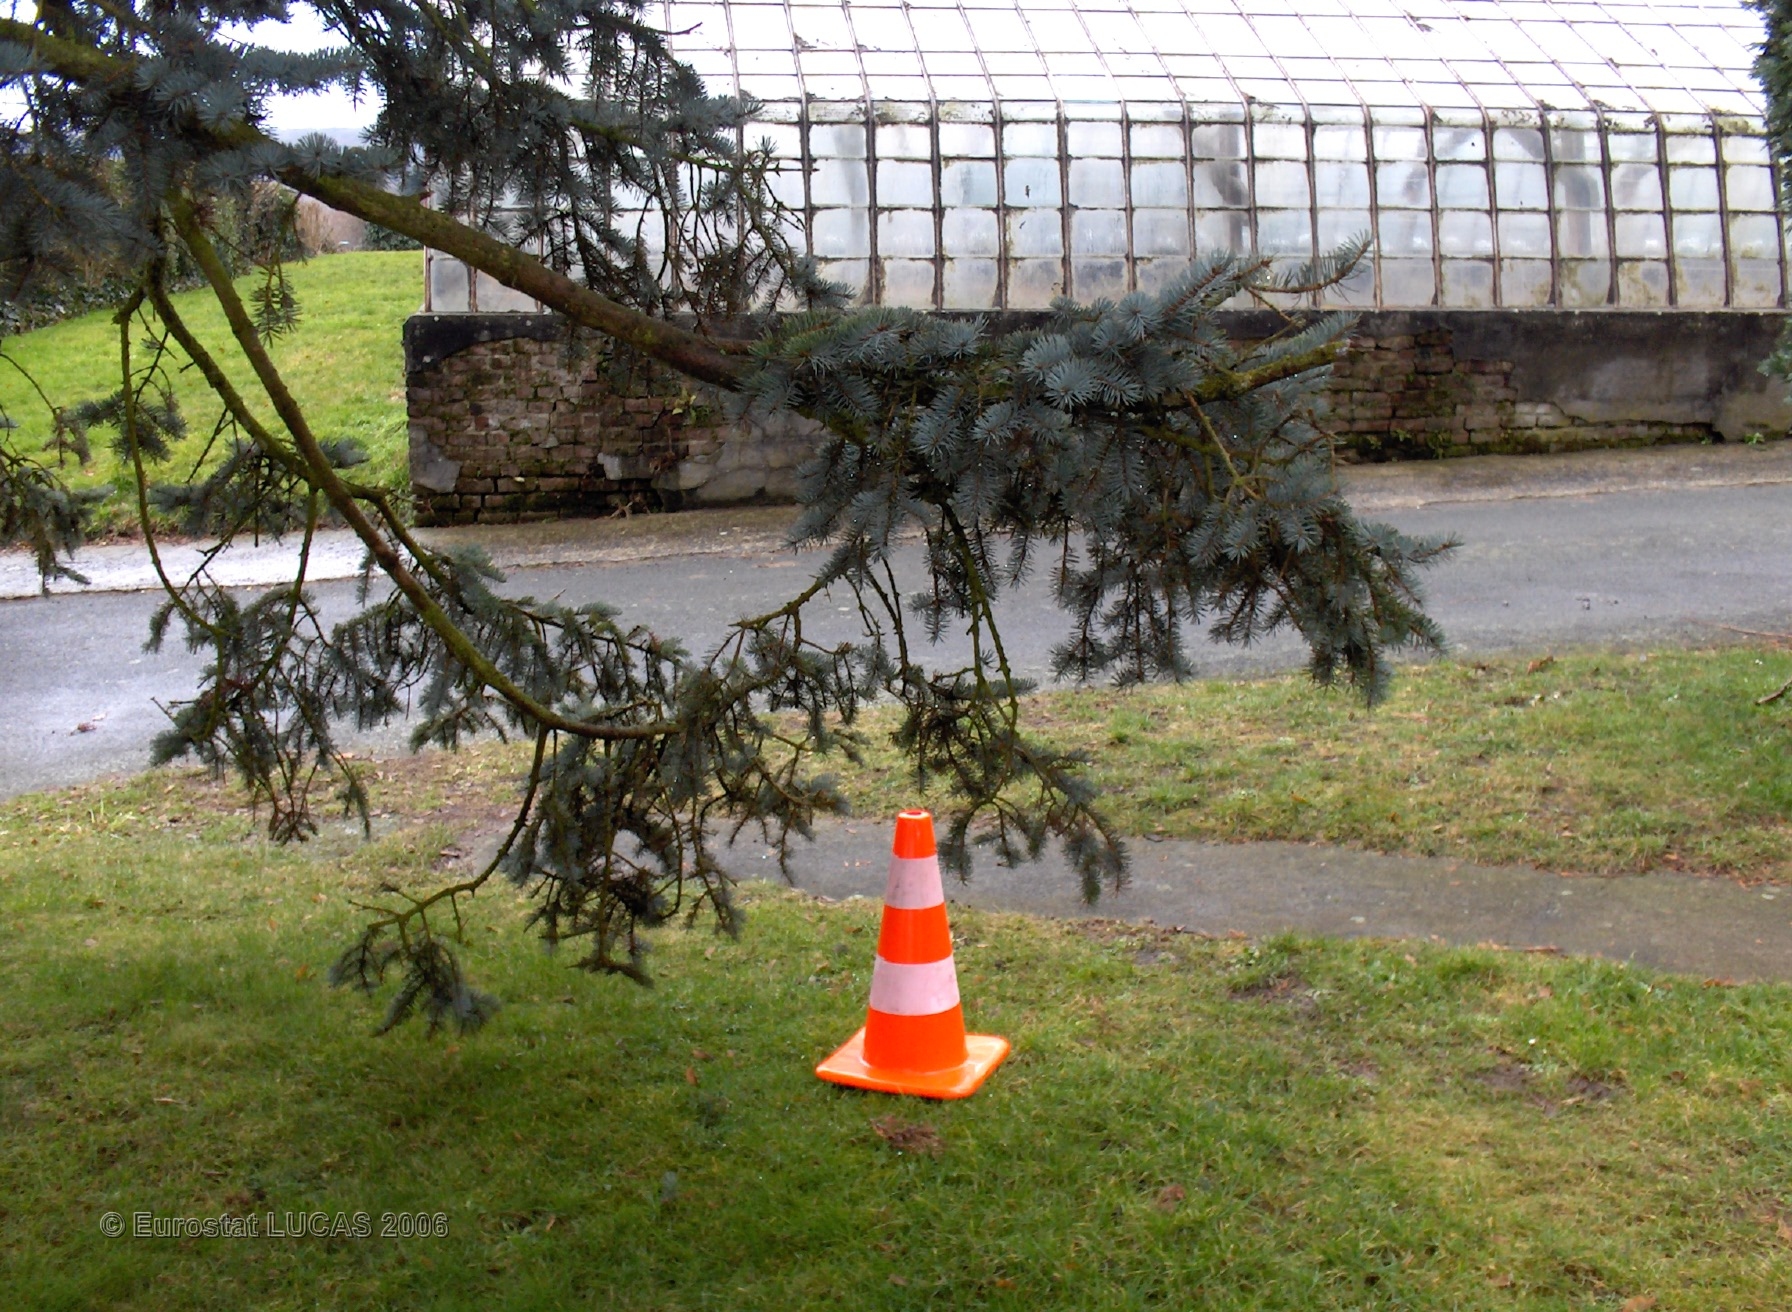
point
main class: Grassland
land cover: Grassland with sparse tree/shrub cover
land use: Residential
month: February
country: BE
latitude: 50.7742
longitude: 4.5363
